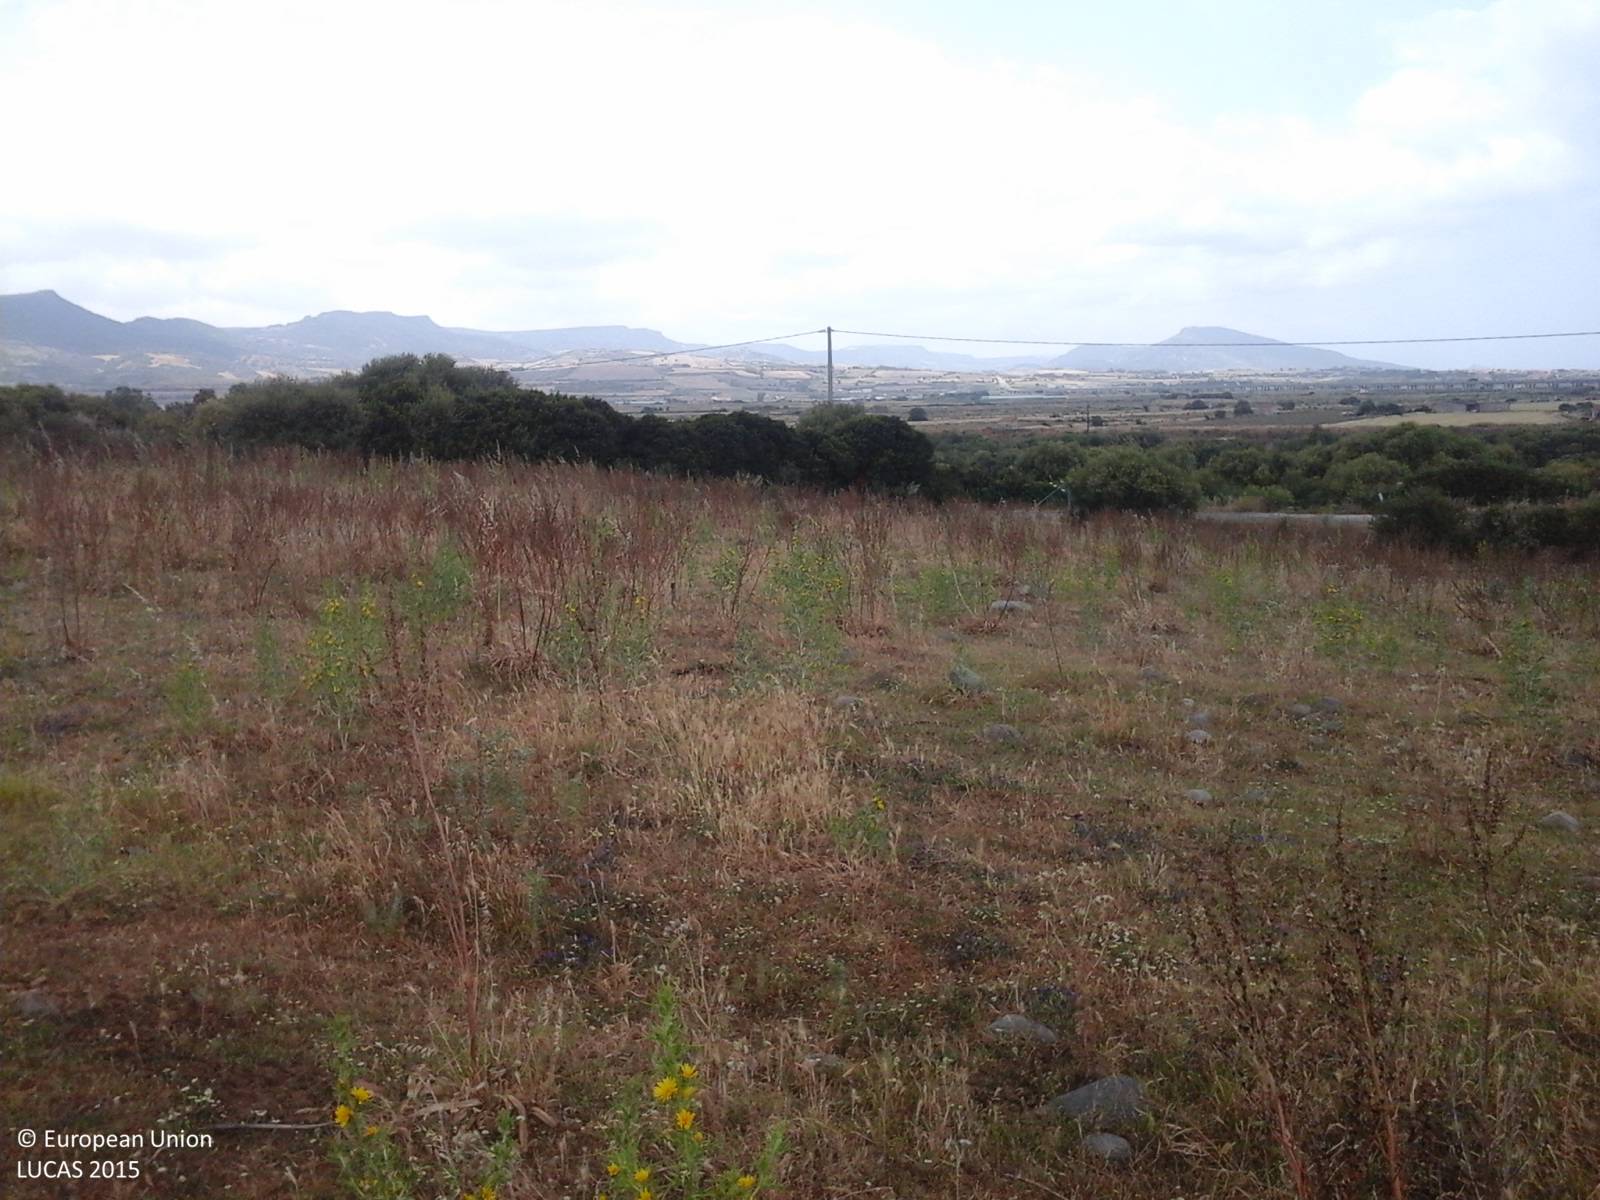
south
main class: Grassland
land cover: Spontaneously vegetated surfaces
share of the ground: > 75 %
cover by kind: herbaceous plants 100 %
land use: Agriculture (excluding fallow land and kitchen gardens)
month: May
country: IT
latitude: 40.9305
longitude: 8.8770
